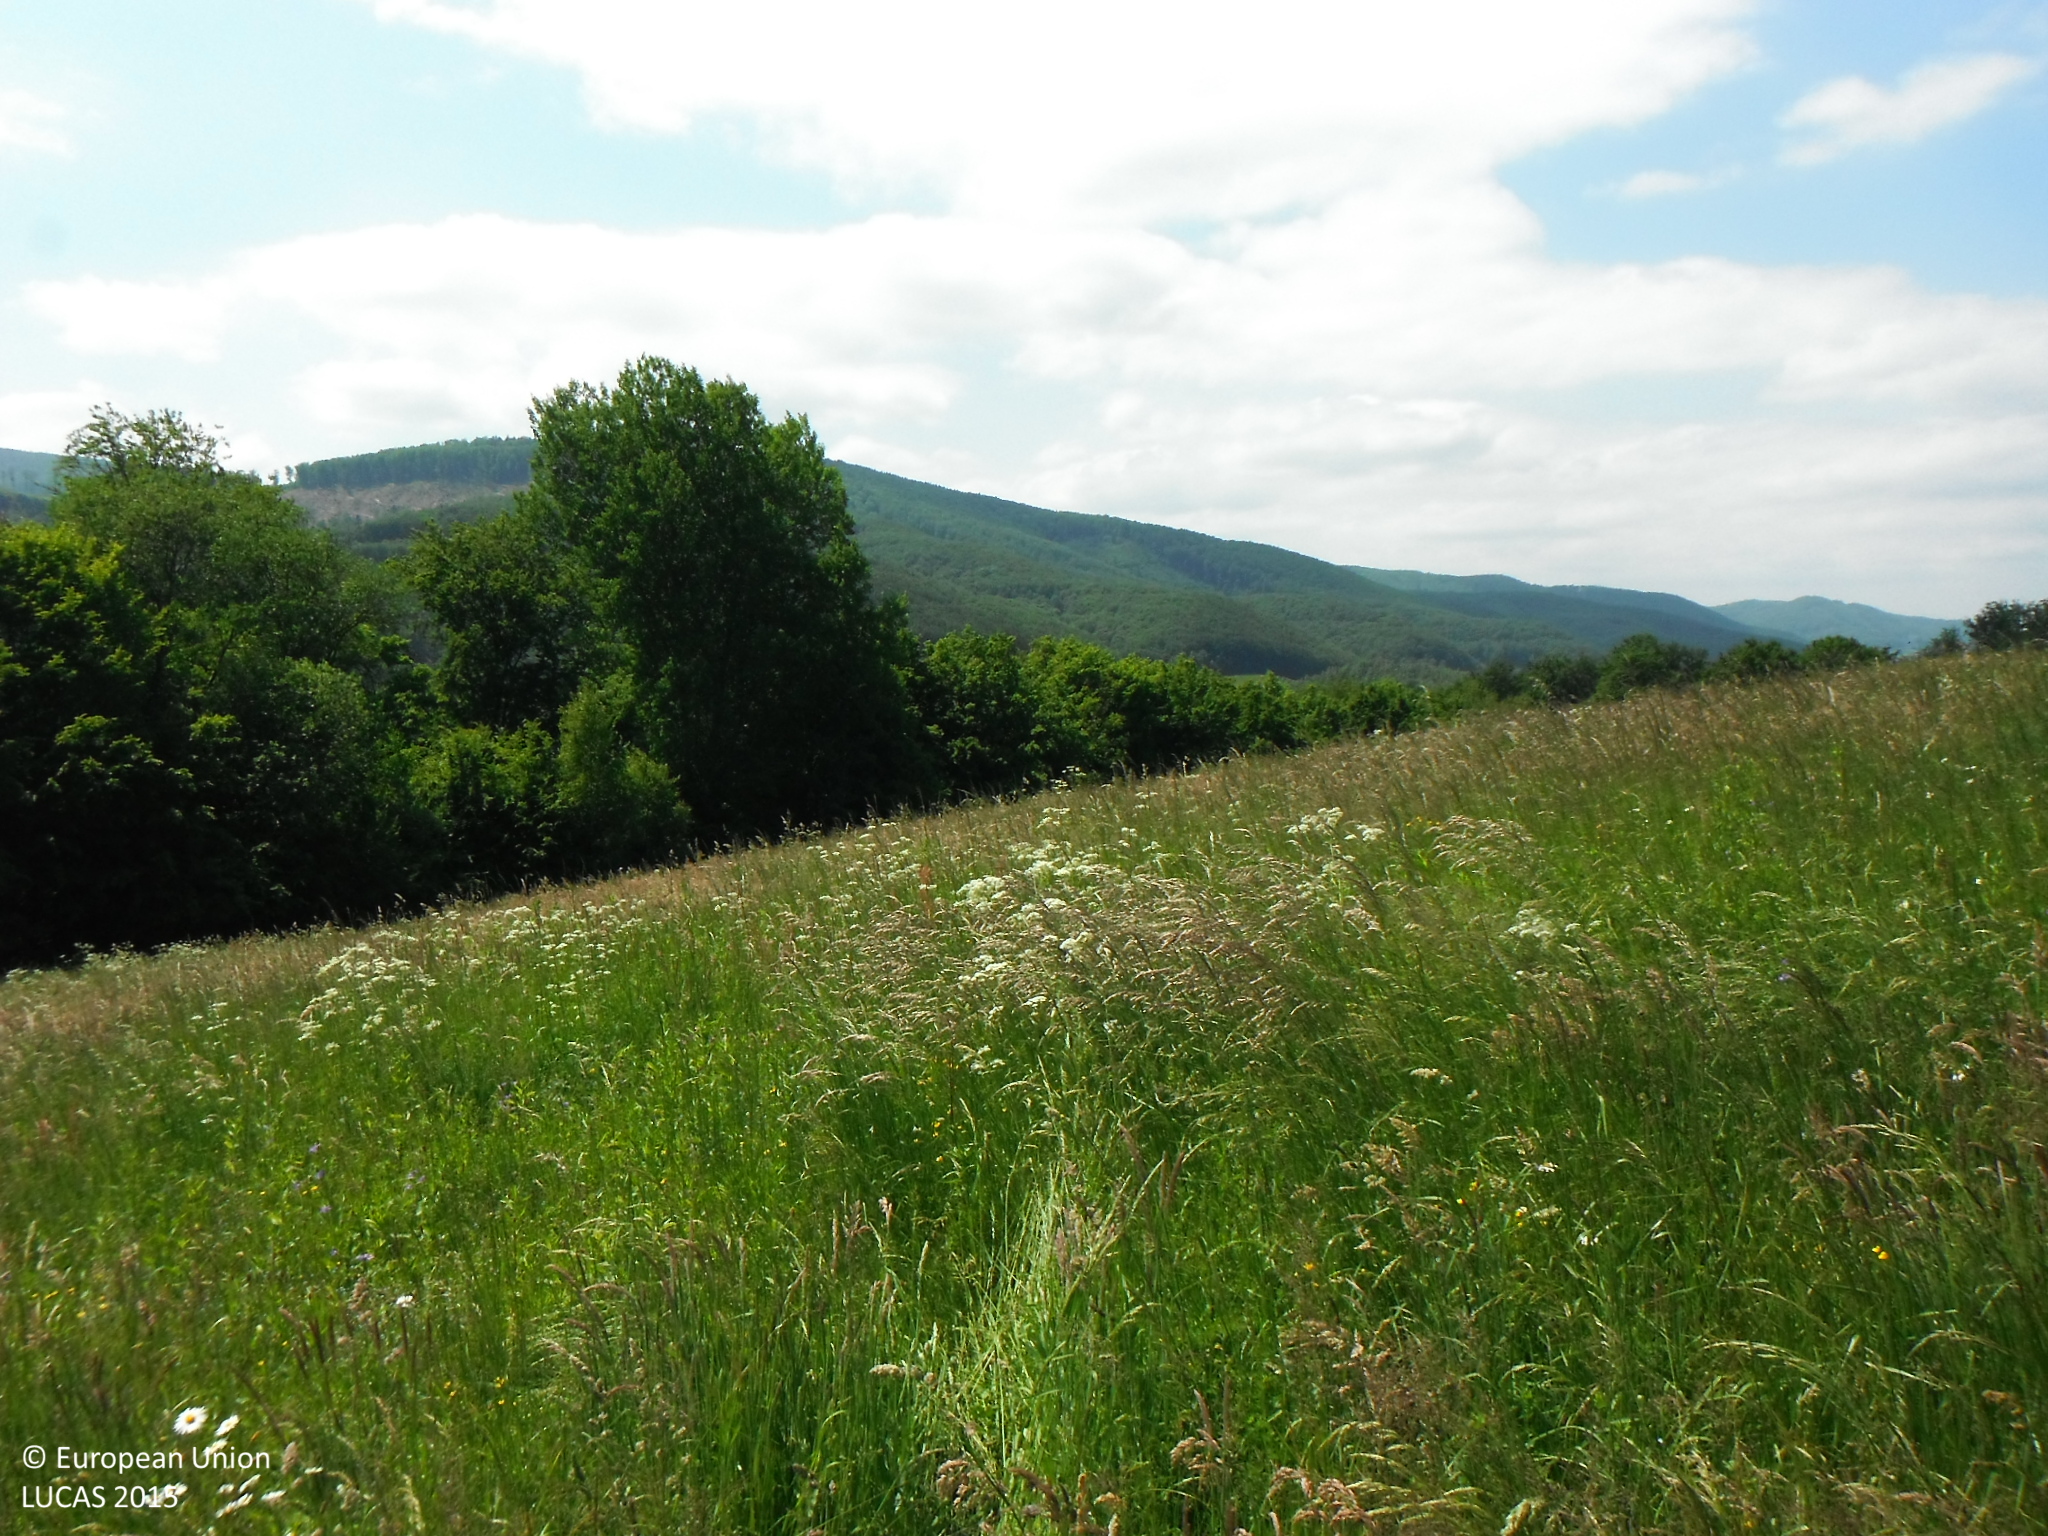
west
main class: Grassland
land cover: Grassland without tree/shrub cover
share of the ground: > 75 %
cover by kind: herbaceous plants 100 %
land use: Agriculture (excluding fallow land and kitchen gardens)
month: June
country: SK
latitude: 48.7835
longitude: 21.1351
